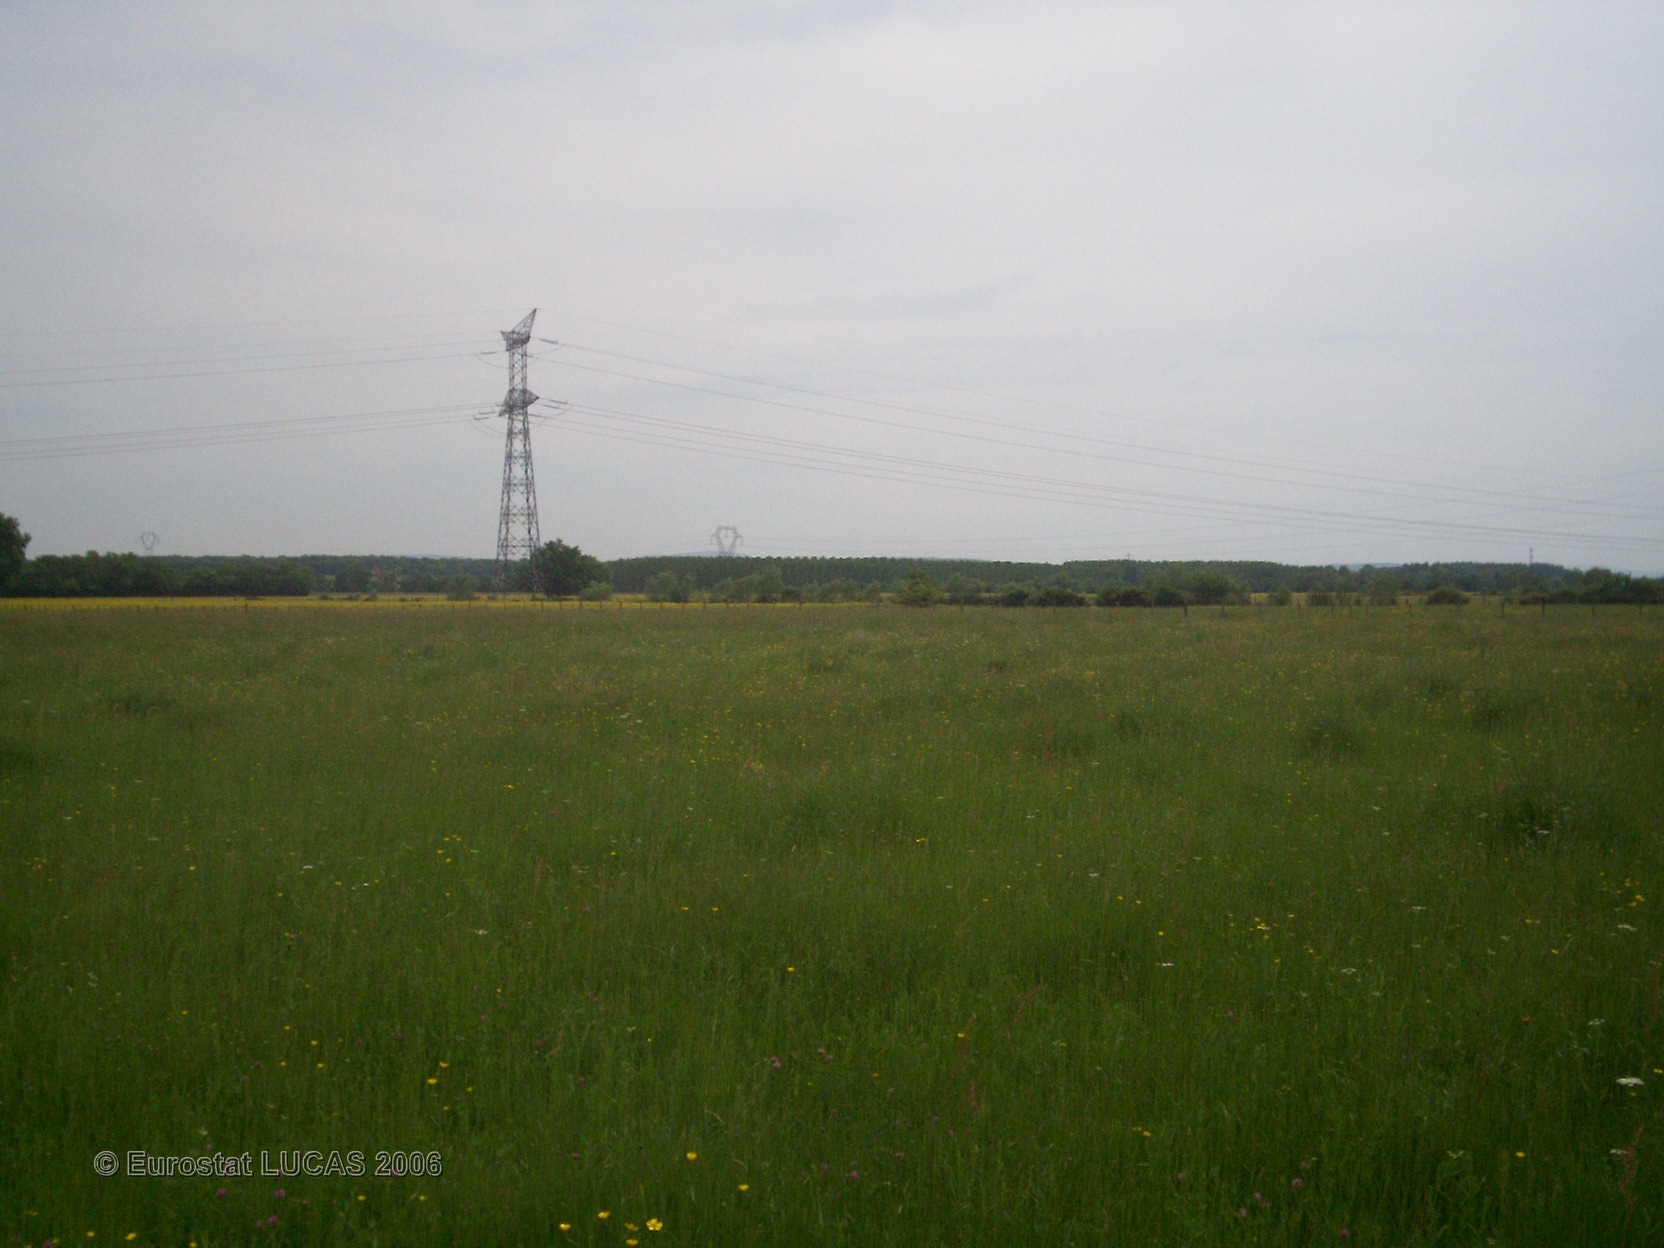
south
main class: Grassland
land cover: Grassland without tree/shrub cover
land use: Agriculture (excluding fallow land and kitchen gardens)
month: May
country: FR
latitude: 46.6367
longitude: 4.7370
